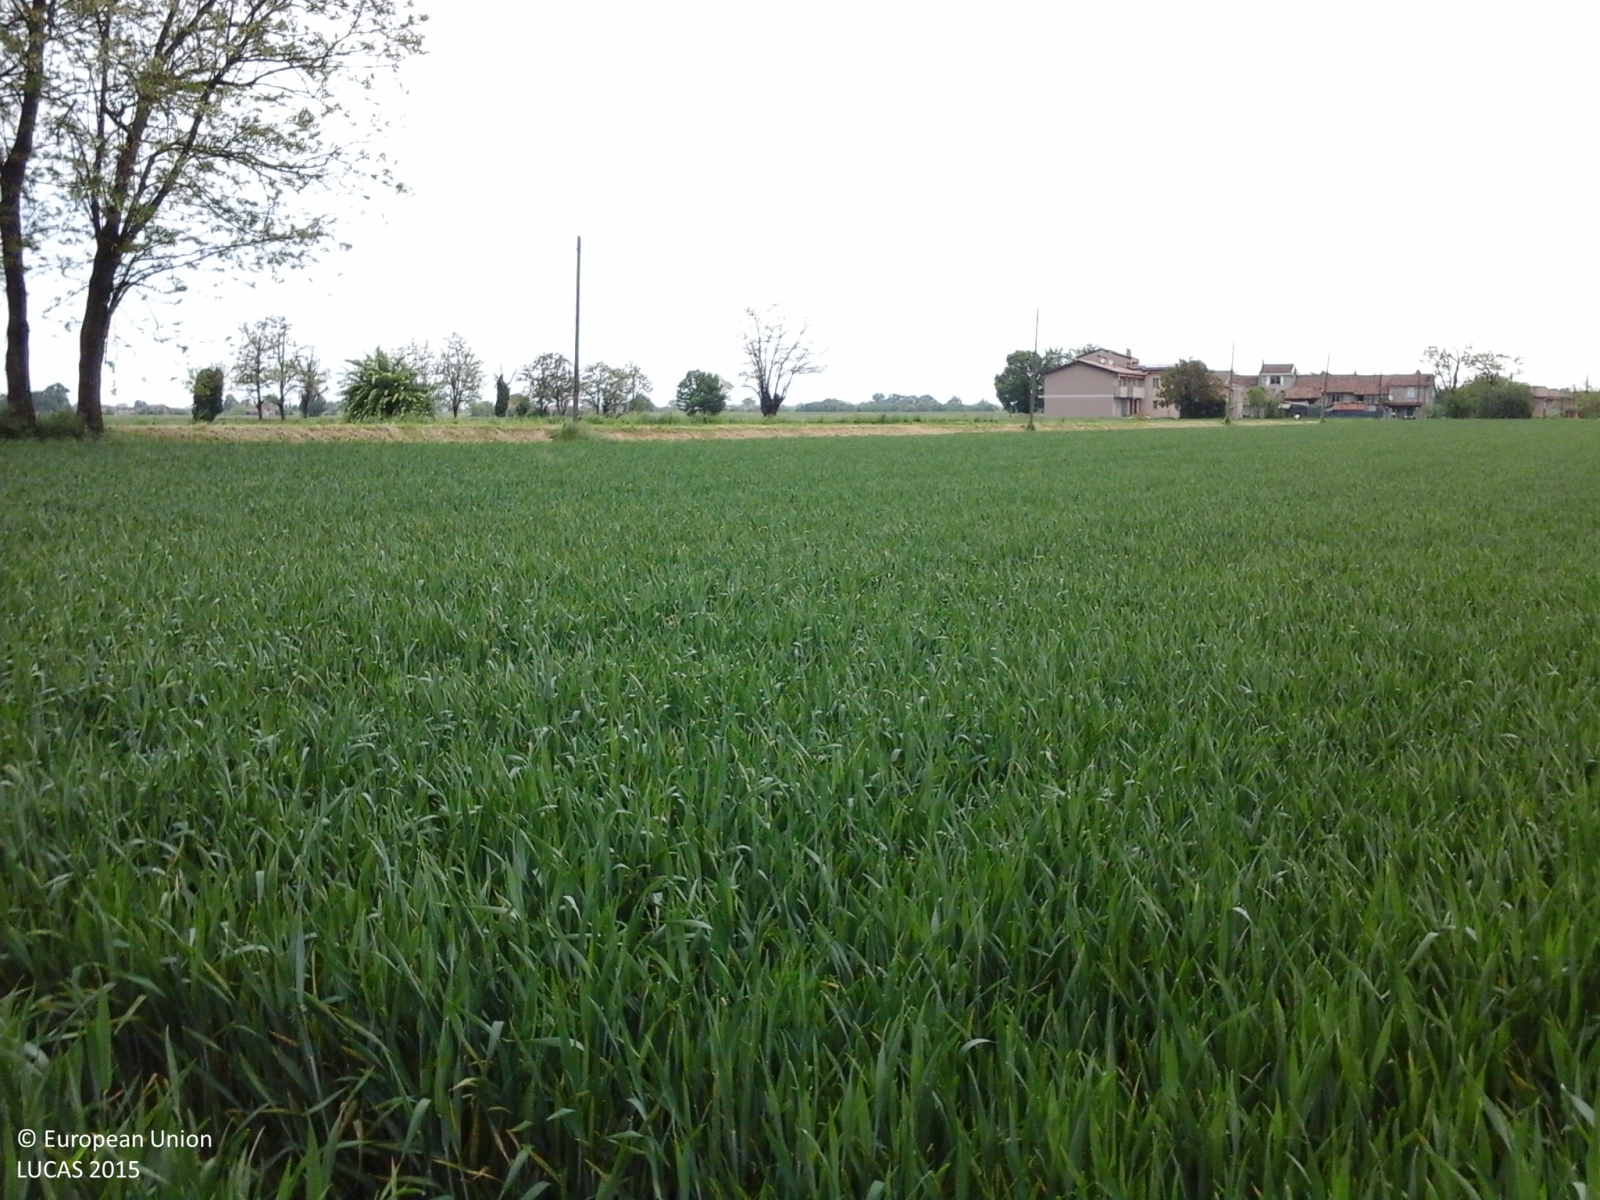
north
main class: Cropland
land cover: Common wheat
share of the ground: > 75 %
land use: Agriculture (excluding fallow land and kitchen gardens)
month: April
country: IT
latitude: 45.0712
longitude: 9.6324
